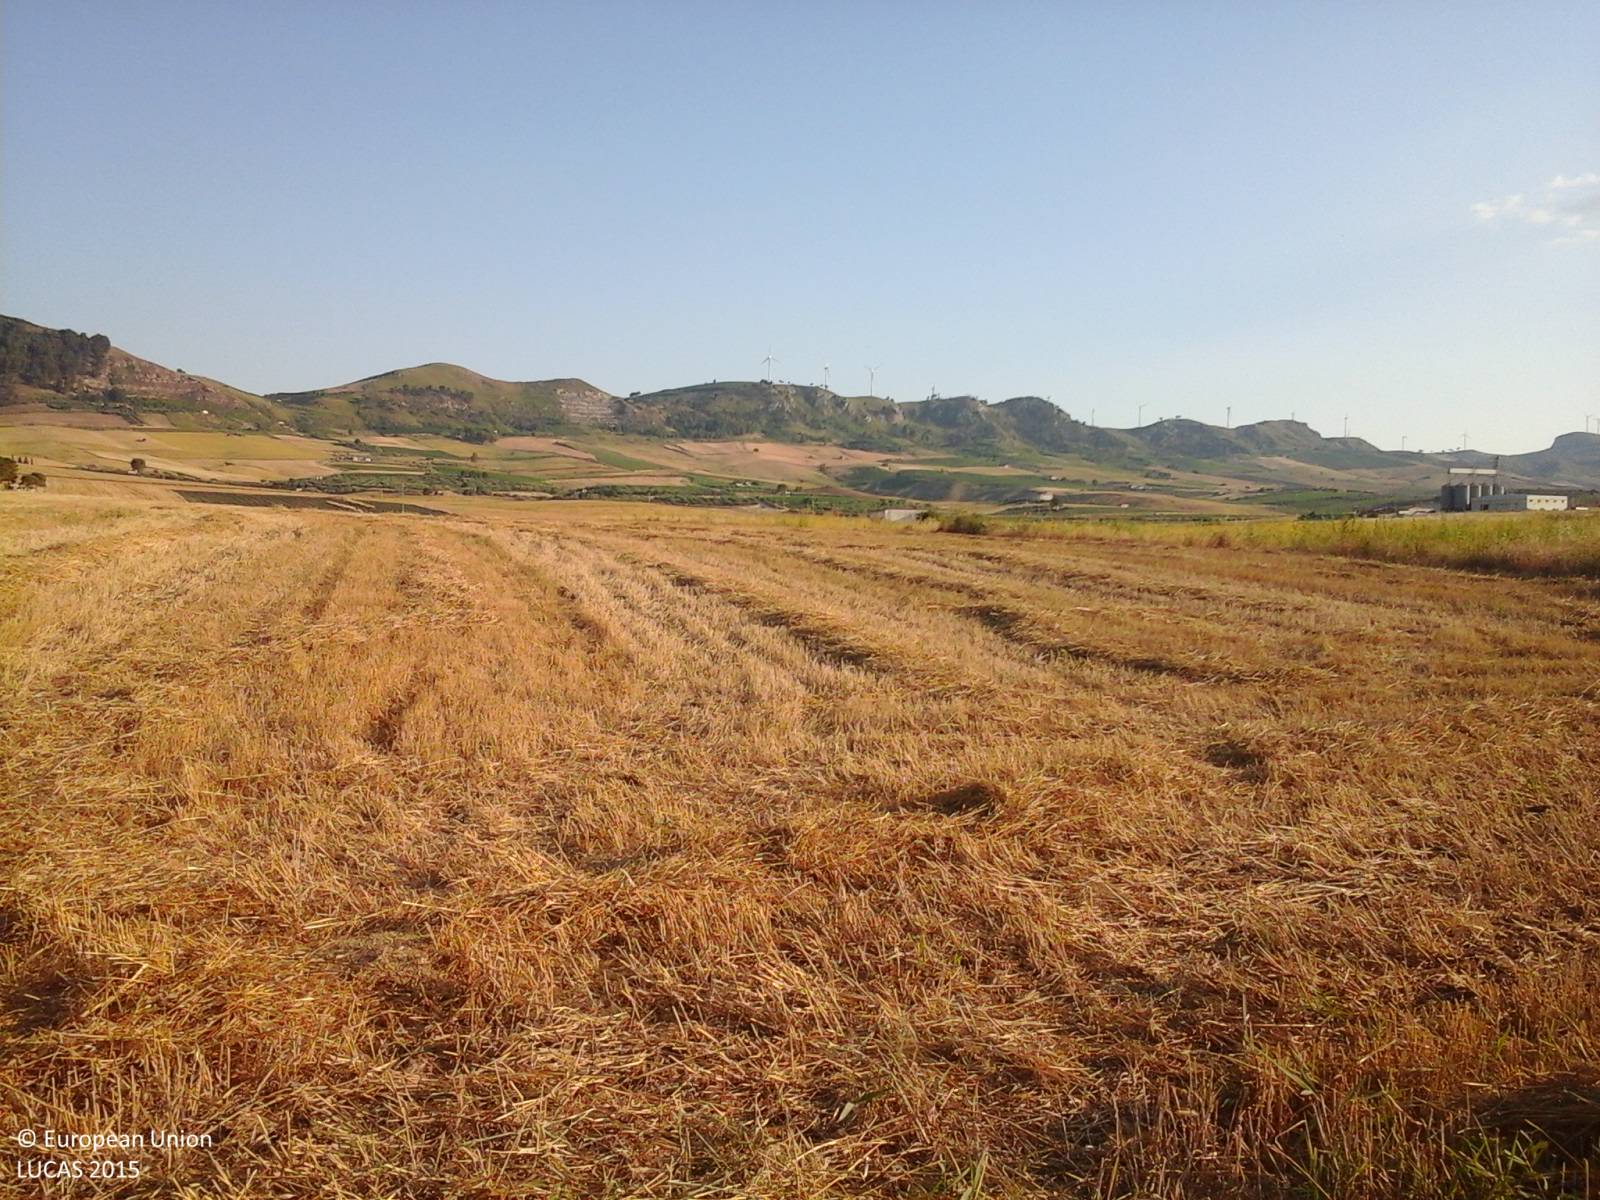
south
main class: Cropland
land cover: Dry pulses
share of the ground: > 75 %
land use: Agriculture (excluding fallow land and kitchen gardens)
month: July
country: IT
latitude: 37.8277
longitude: 12.9888
